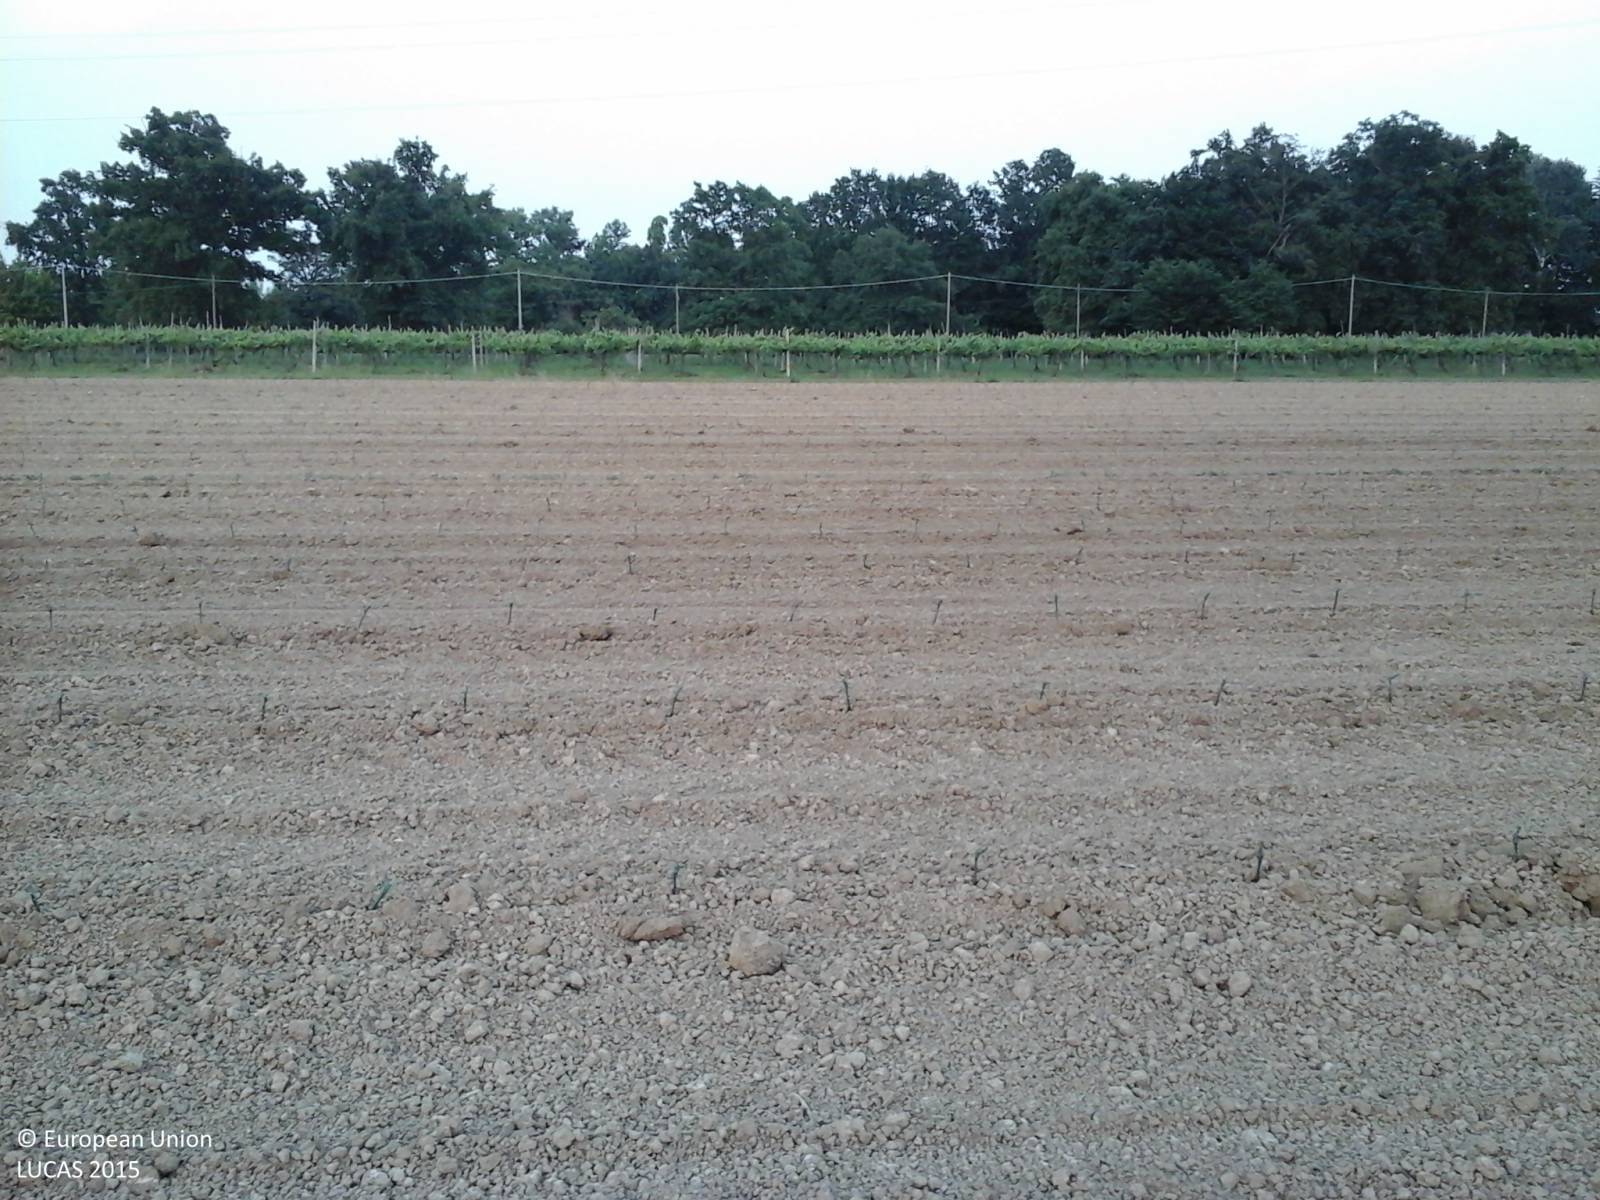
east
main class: Cropland
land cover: Vineyards
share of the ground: < 10 %
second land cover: Other bare soil
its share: > 75 %
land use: Agriculture (excluding fallow land and kitchen gardens)
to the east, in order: Vineyards; Other bare soil; Ditches and canals; Vineyards; Electric lines; Ditches and canals; Vineyards; Ditches and canals; Vineyards; Electric lines; Grassland without tree/shrub cover; Electric lines; Grass margins; Paved roads, cycling and walking lanes; Grass margins; Grassland without tree/shrub cover; Single bushes/trees; Grassland without tree/shrub cover; Broadleaved woodland; Grassland without tree/shrub cover; Broadleaved woodland; Artificial constructions in urban areas
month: June
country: IT
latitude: 45.8166
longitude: 13.2007
